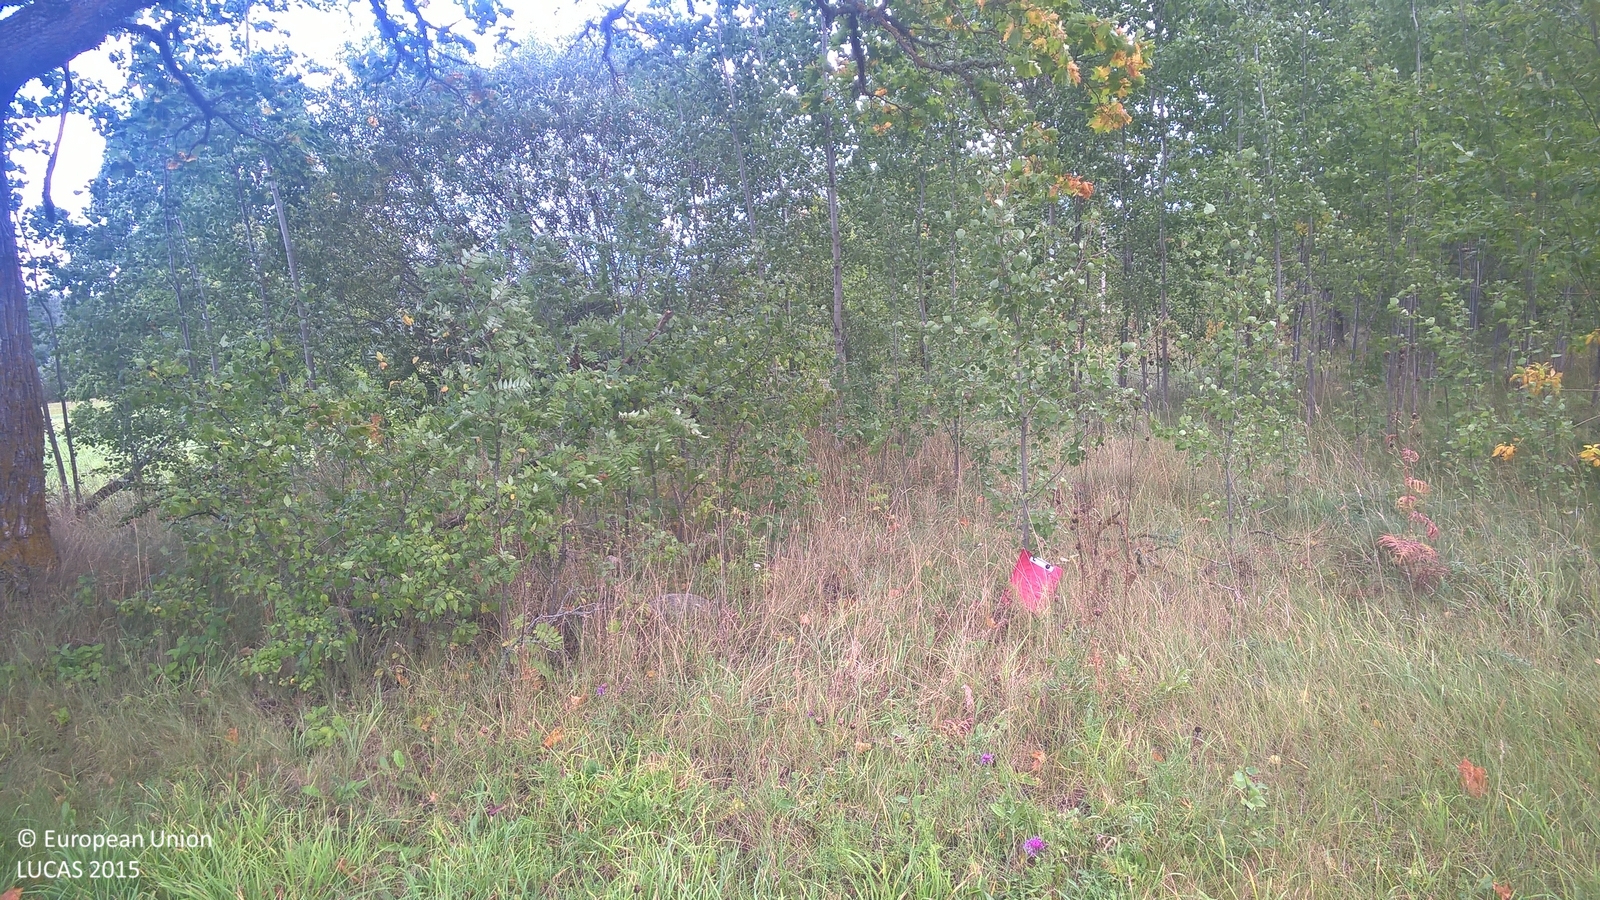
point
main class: Woodland
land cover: Broadleaved woodland
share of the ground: 10 - 25 %
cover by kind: herbaceous plants 70 %, broadleaved forest trees 20 %, shrubs 5 %, lichens and mosses 5 %
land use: Forestry
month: September
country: LV
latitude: 57.4603
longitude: 25.9461
